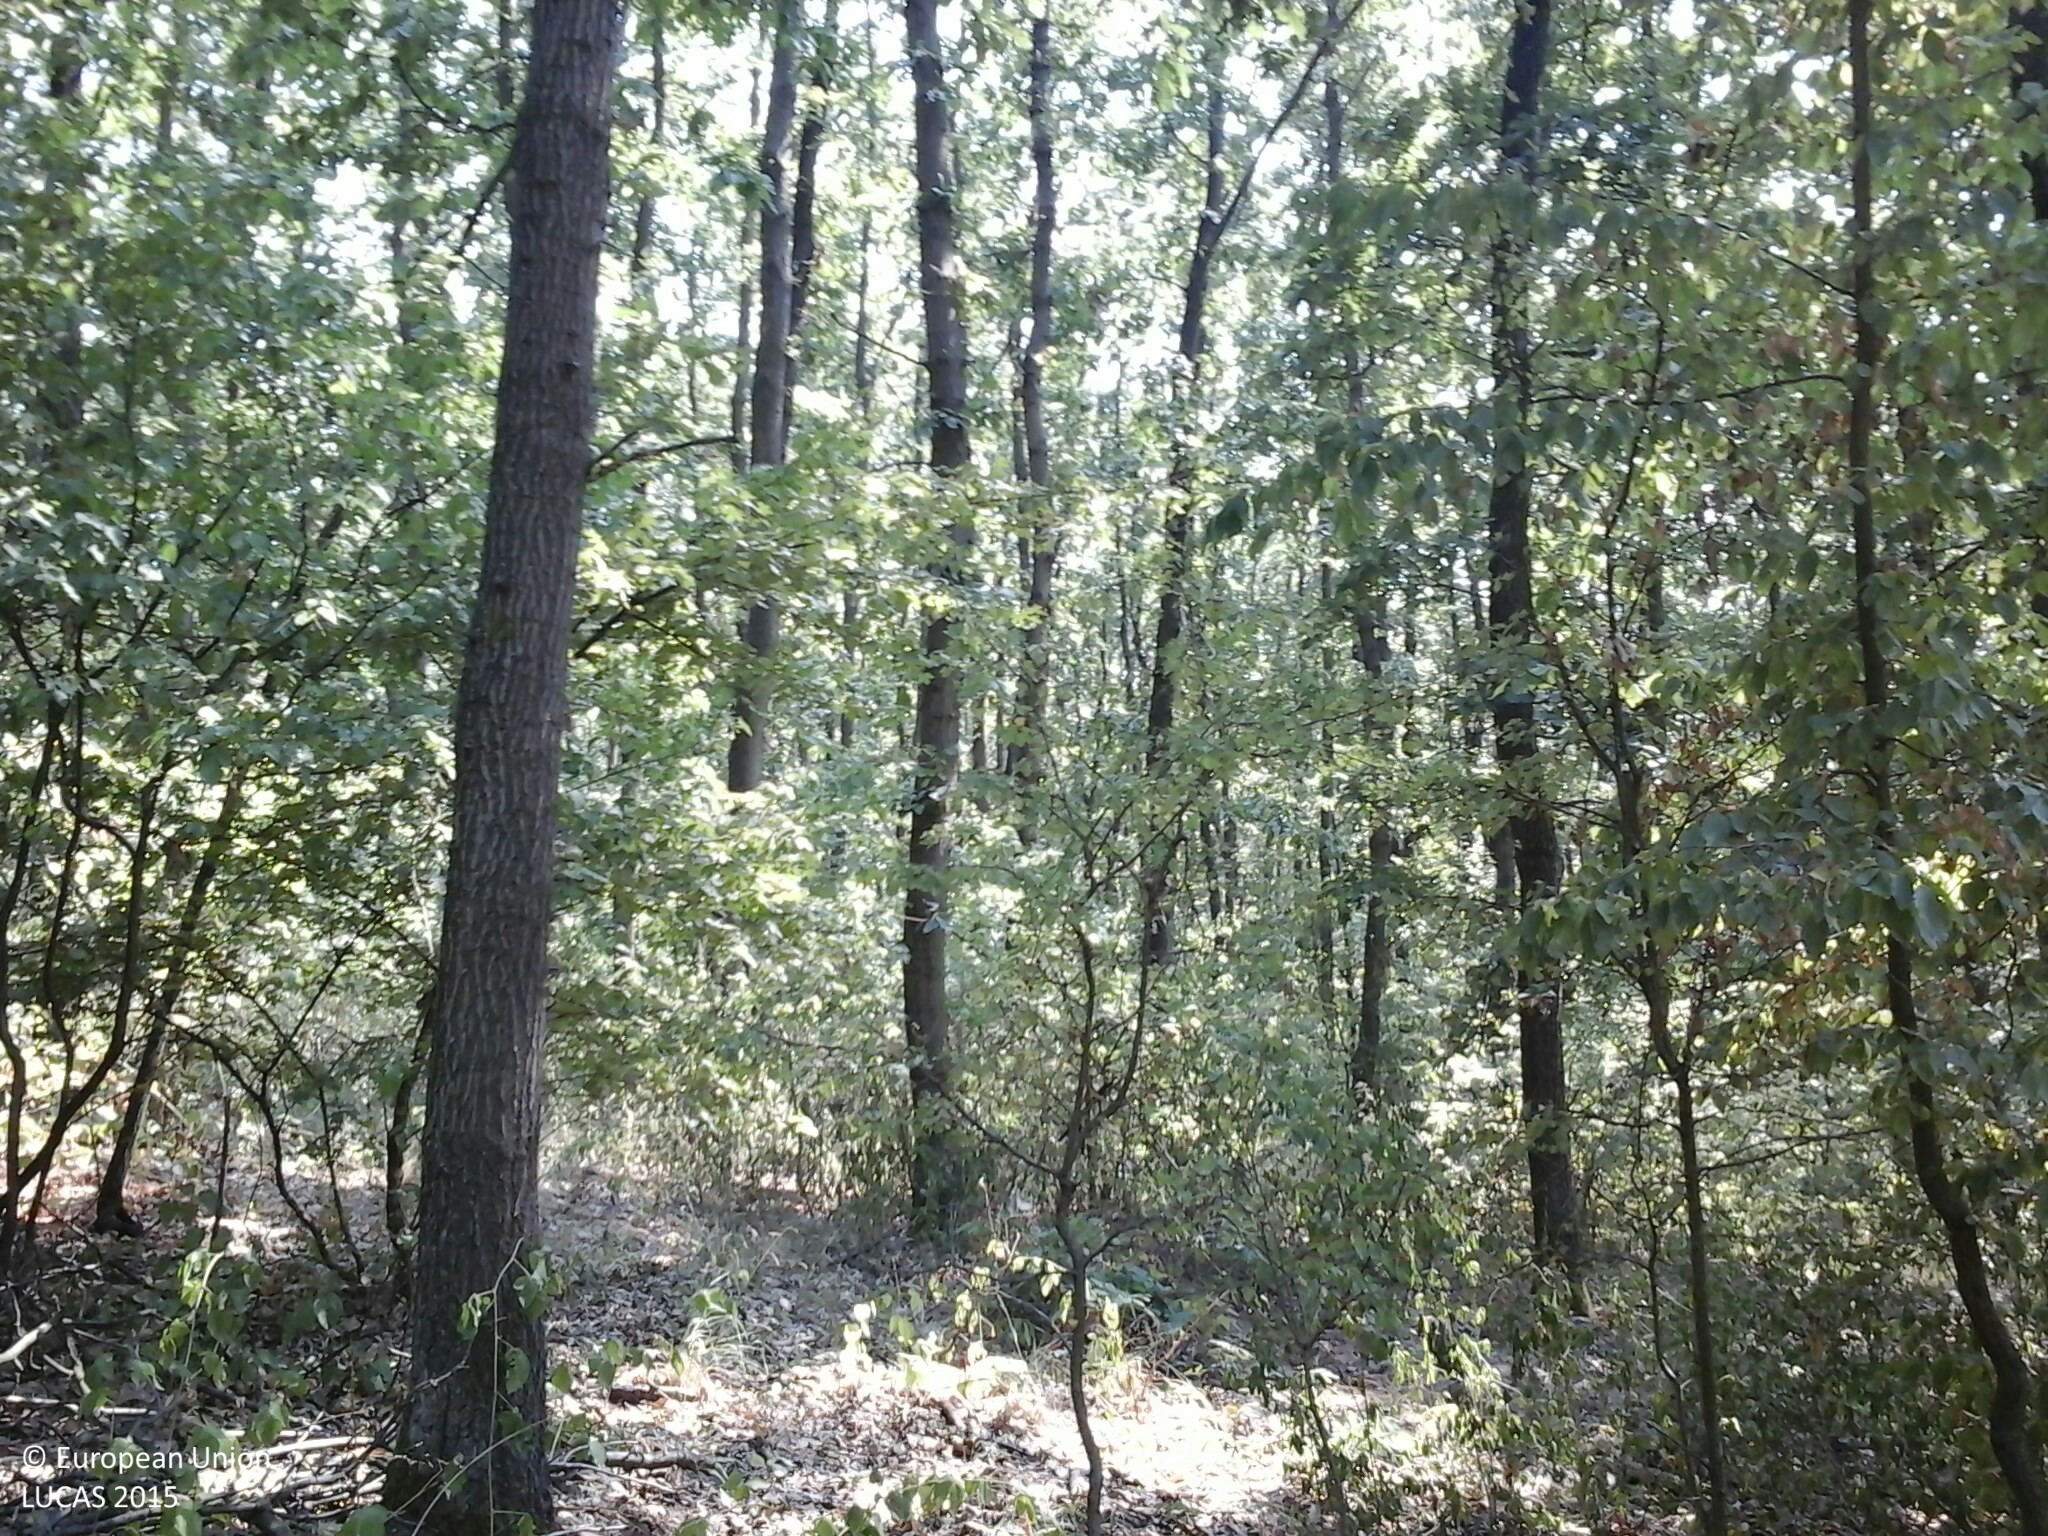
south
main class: Woodland
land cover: Broadleaved woodland
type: thermophilous deciduous forest
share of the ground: > 75 %
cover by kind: broadleaved forest trees 70 %, shrubs 20 %, herbaceous plants 10 %
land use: Forestry
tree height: > 5 m
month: August
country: HU
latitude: 47.9519
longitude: 19.1388
